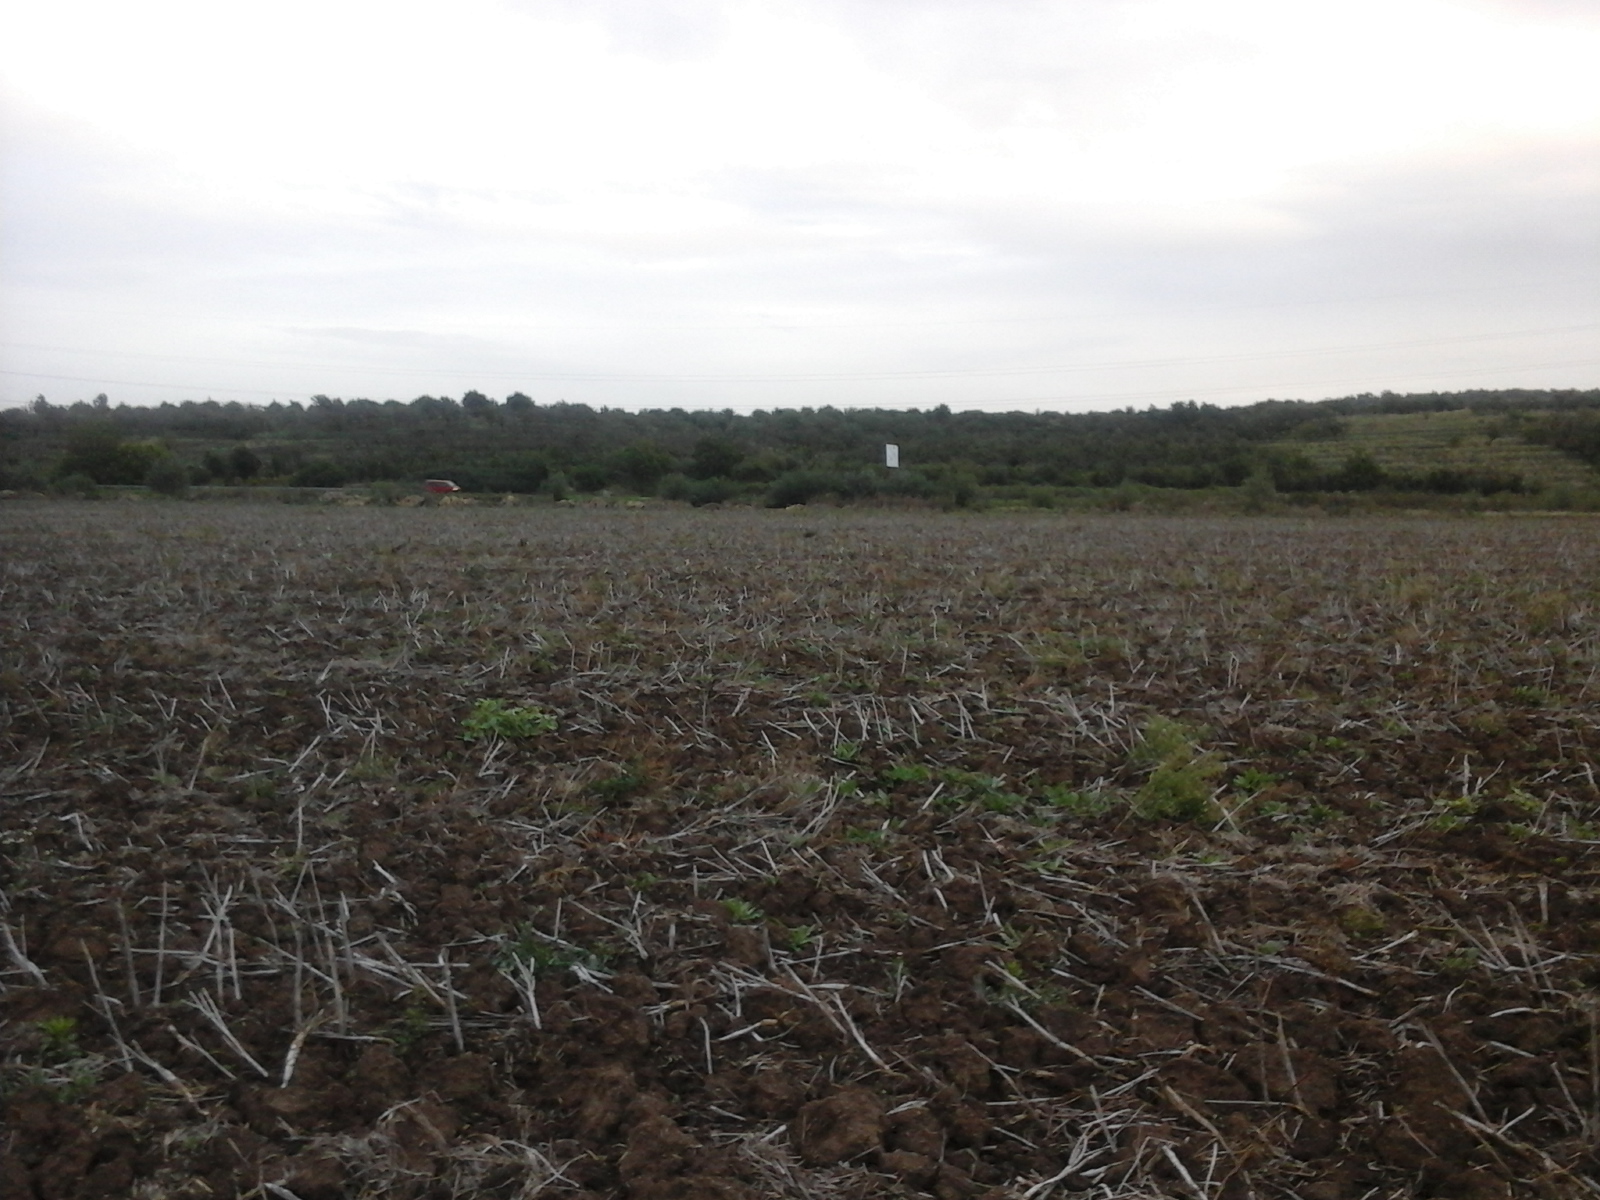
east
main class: Cropland
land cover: Rape and turnip rape
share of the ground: < 10 %
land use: Agriculture (excluding fallow land and kitchen gardens)
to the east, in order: Rape and turnip rape; Abandoned hedges; Ditches and canals; Abandoned hedges; Grass margins; Electric lines; Paved roads, cycling and walking lanes; Spontaneously vegetated surfaces; Shrubland without tree cover
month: September
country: RO
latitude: 47.1221
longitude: 21.8960
